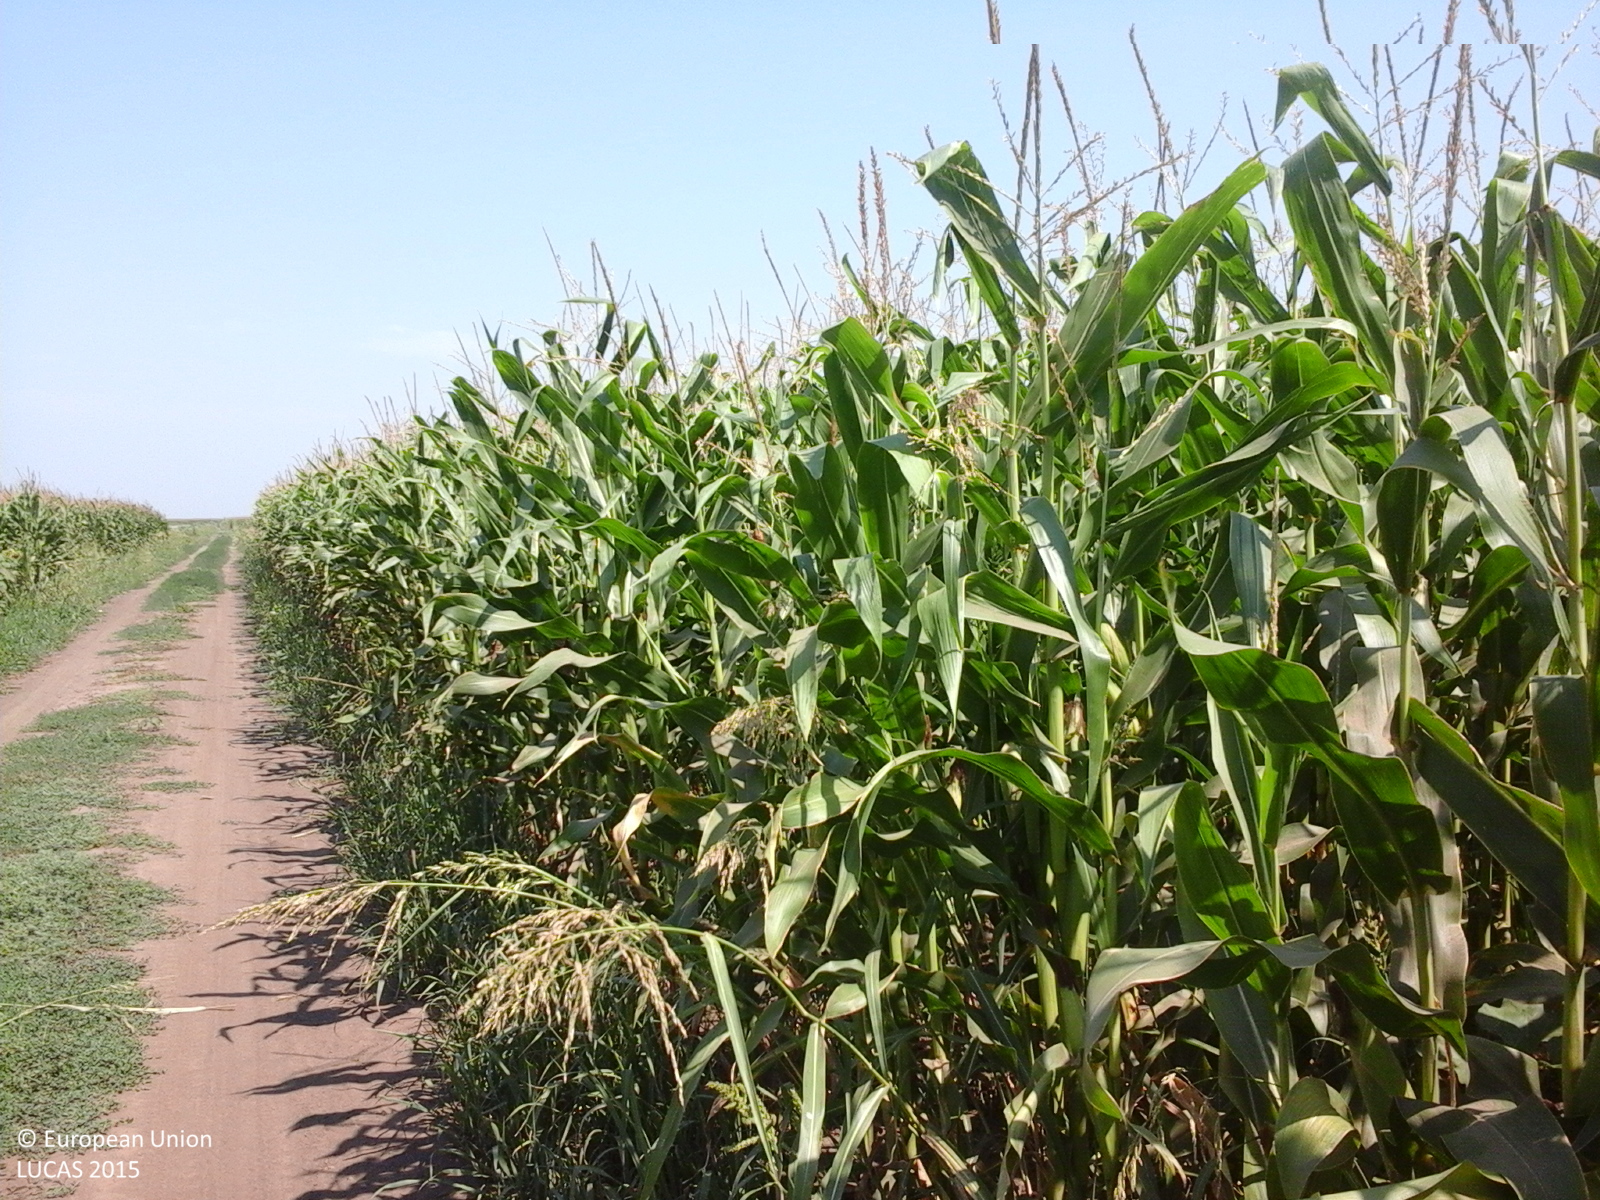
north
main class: Cropland
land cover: Maize
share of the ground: > 75 %
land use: Agriculture (excluding fallow land and kitchen gardens)
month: August
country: RO
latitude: 45.1798
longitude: 27.4428
